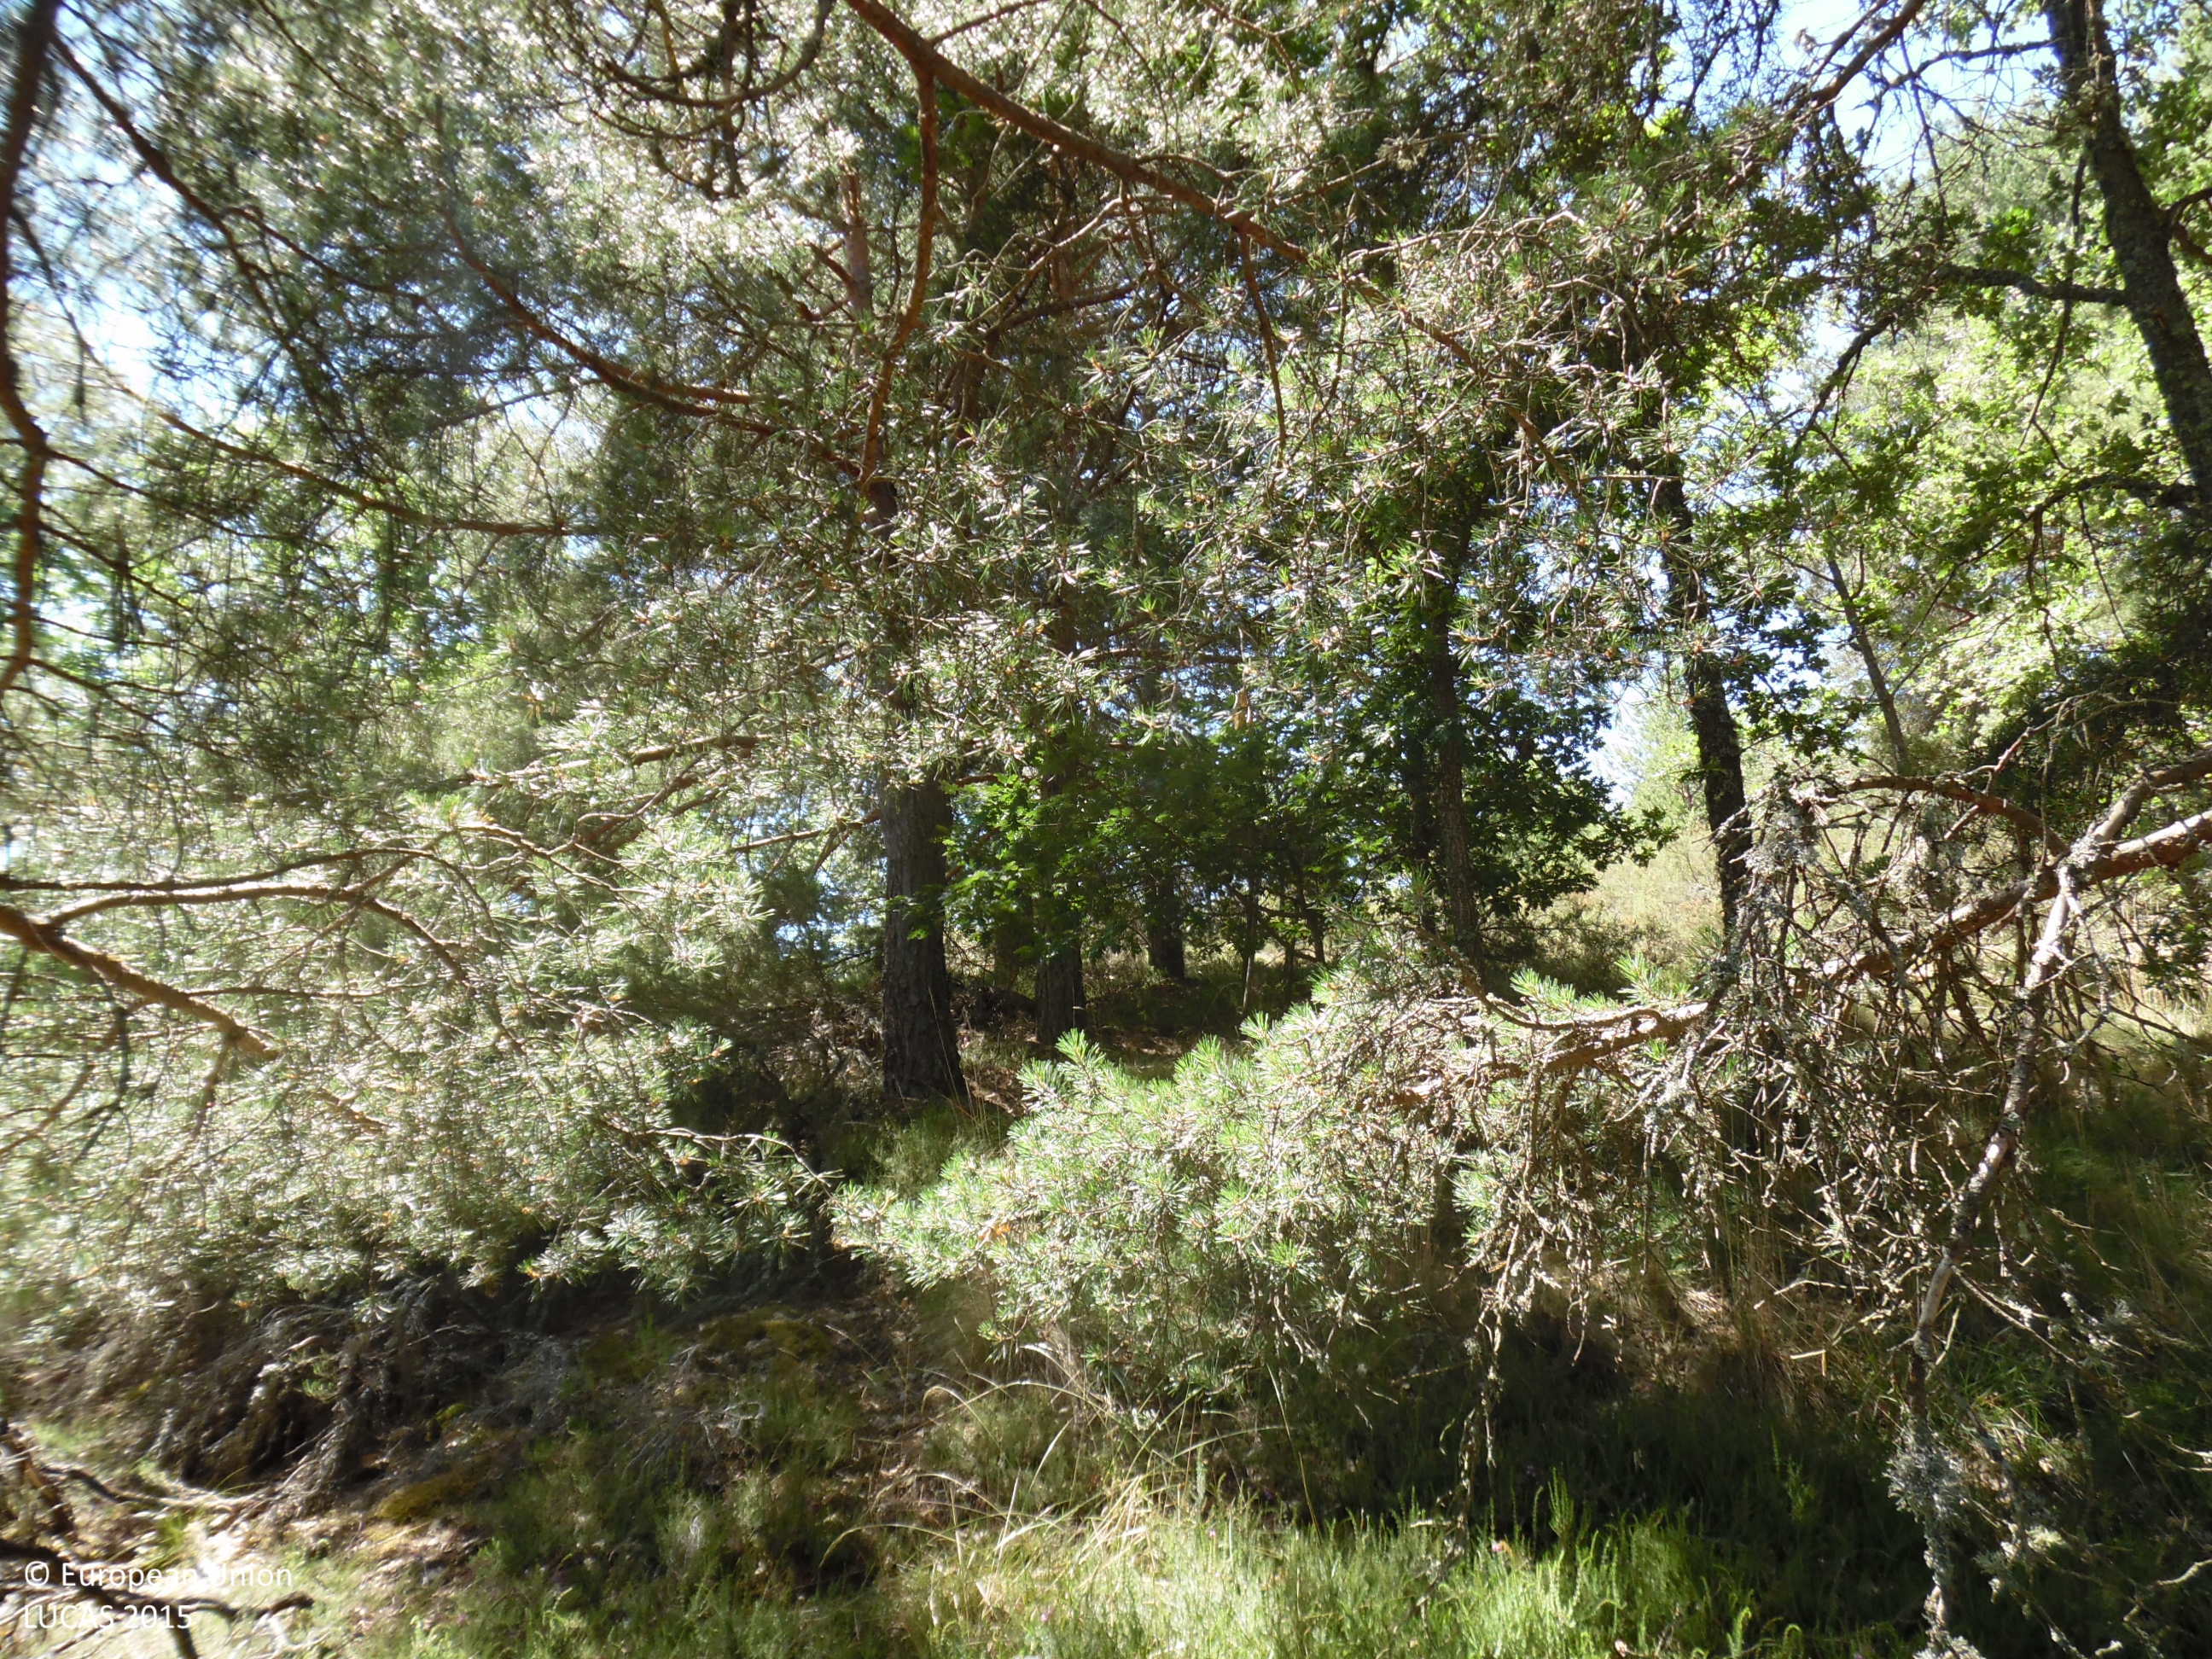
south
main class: Woodland
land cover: Pine dominated coniferous woodland
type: coniferous forest of the mediterranean region
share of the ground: 50 - 75 %
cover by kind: coniferous forest trees 95 %, shrubs 5 %
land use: Forestry
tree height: > 5 m
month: June
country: ES
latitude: 42.5433
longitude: -6.1460
